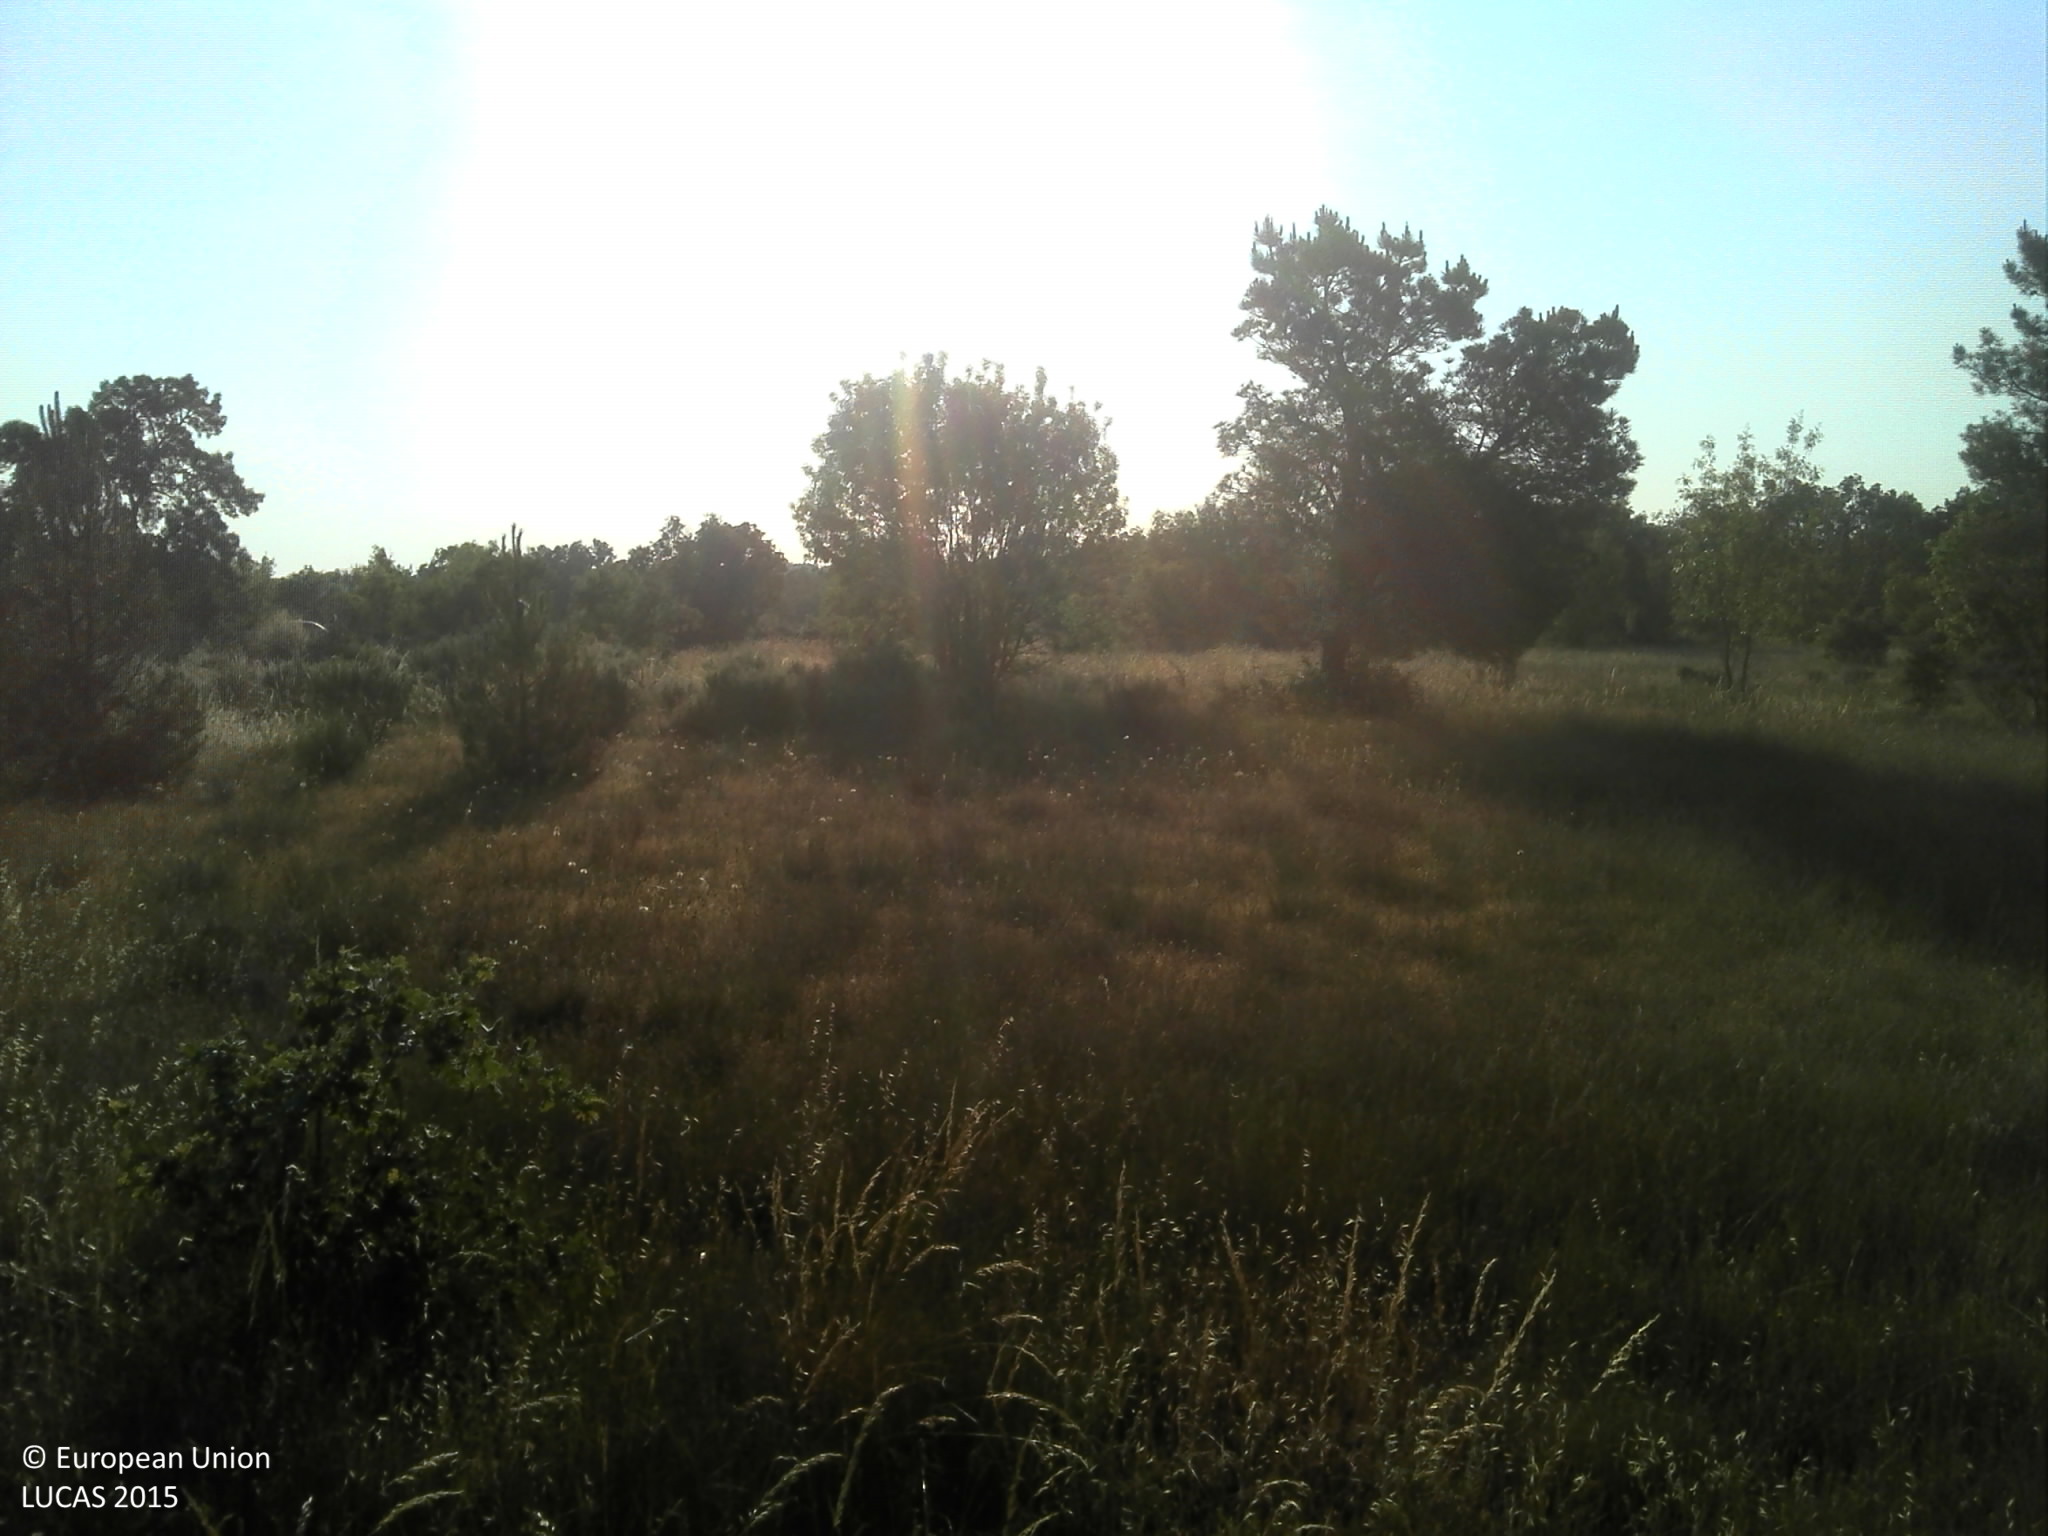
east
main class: Grassland
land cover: Grassland without tree/shrub cover
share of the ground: 50 - 75 %
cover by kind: herbaceous plants 70 %, unconsolidated bare surface 20 %
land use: Agriculture (excluding fallow land and kitchen gardens)
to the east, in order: Grassland without tree/shrub cover; Single bushes/trees; Grassland without tree/shrub cover; Ditches and canals; Grassland without tree/shrub cover; Dry stone walls; Tracks; Dry stone walls; Grassland without tree/shrub cover; Abandoned hedges; Dry stone walls; Grassland without tree/shrub cover; Abandoned hedges; Dry stone walls; Grassland without tree/shrub cover; Abandoned hedges; Dry stone walls; Grassland without tree/shrub cover; Single bushes/trees
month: June
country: PT
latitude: 40.5637
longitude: -6.9772
